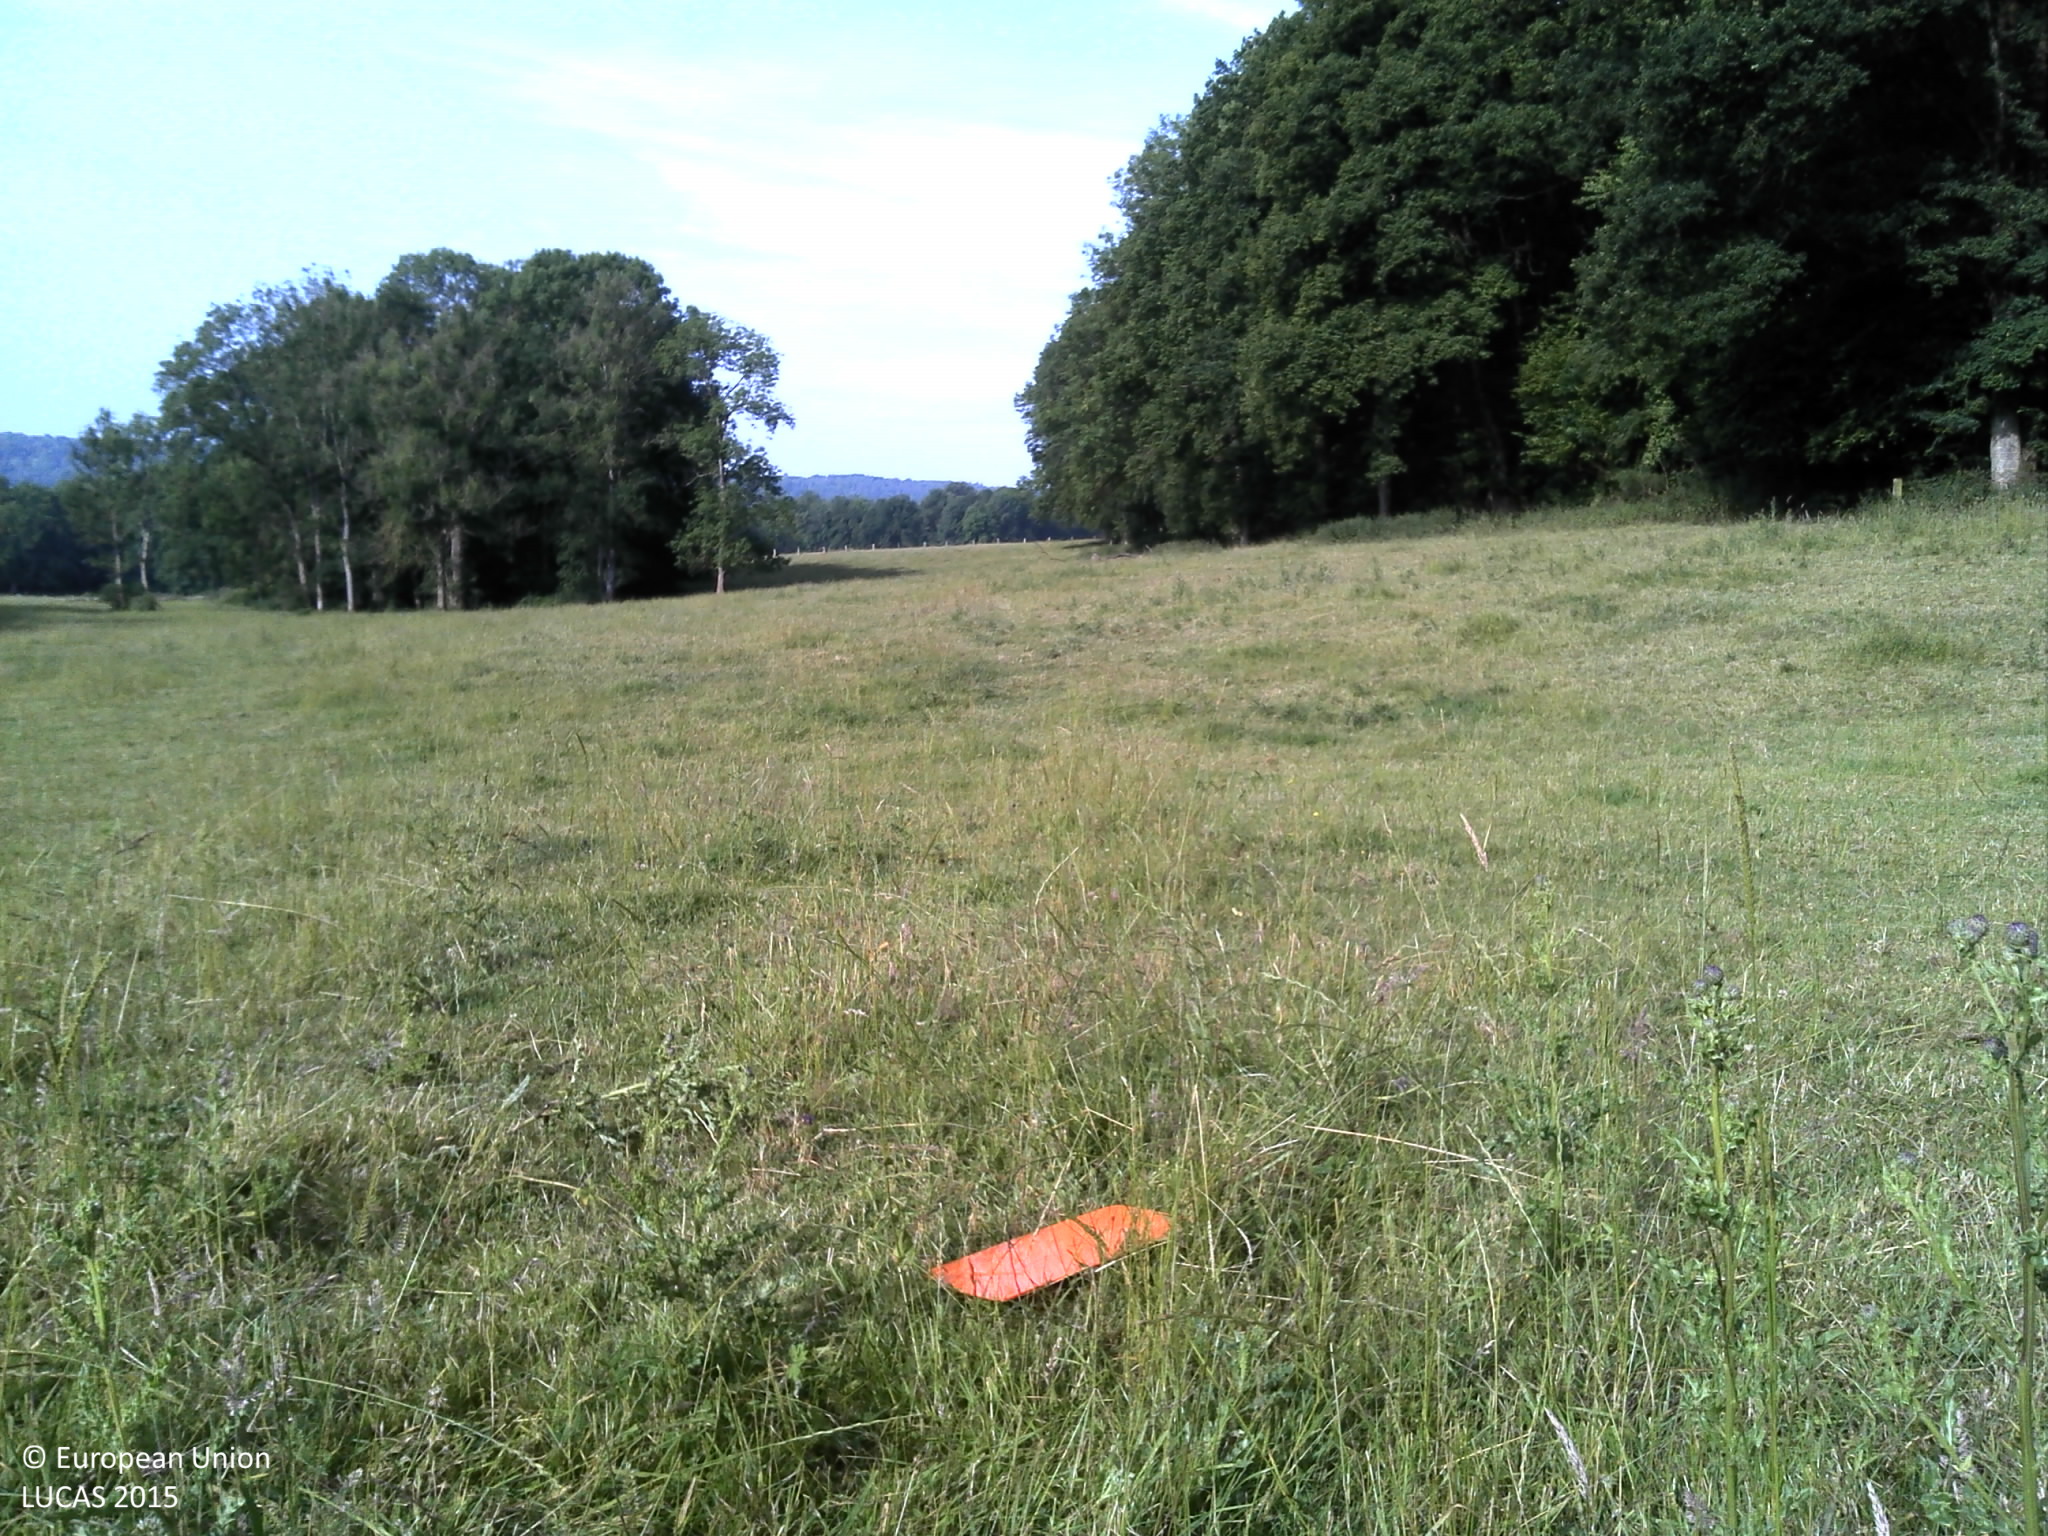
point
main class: Grassland
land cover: Grassland without tree/shrub cover
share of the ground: > 75 %
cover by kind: herbaceous plants 100 %
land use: Agriculture (excluding fallow land and kitchen gardens)
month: June
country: FR
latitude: 49.7064
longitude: 4.8248
